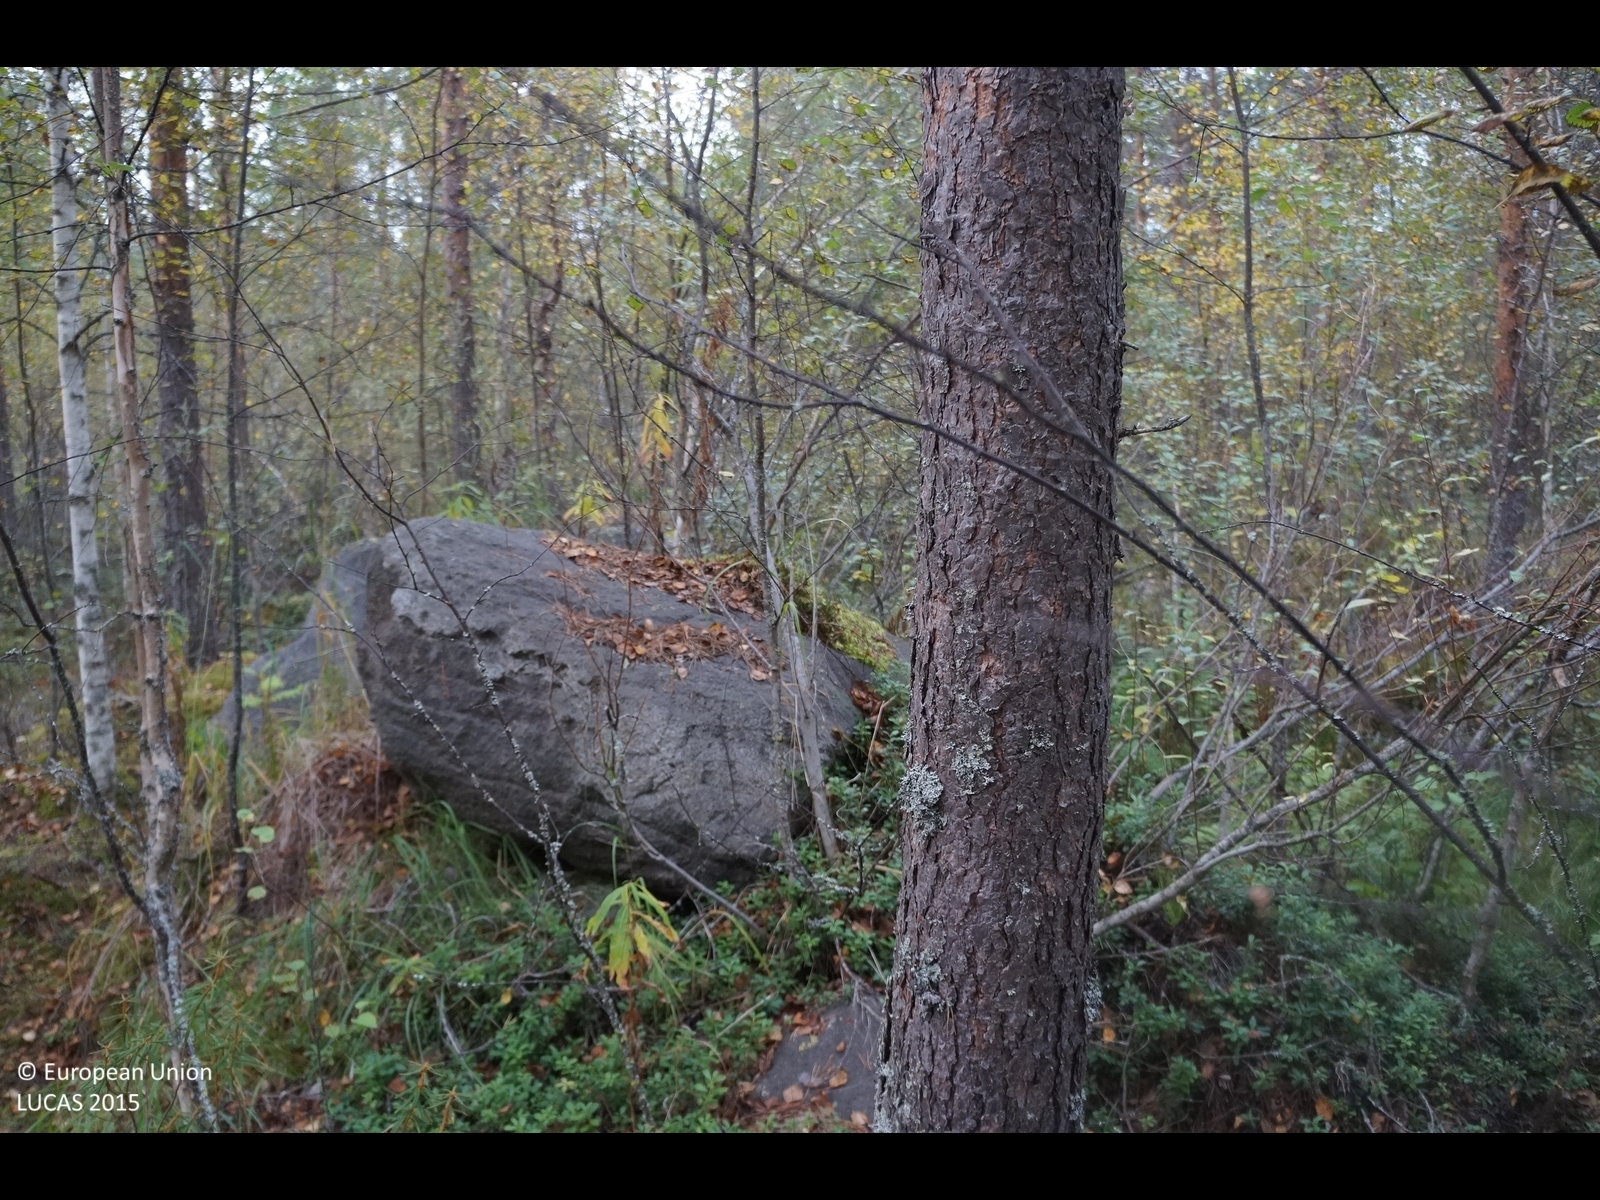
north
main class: Woodland
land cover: Pine dominated mixed woodland
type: boreal forest
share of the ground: 50 - 75 %
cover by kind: coniferous forest trees 40 %, broadleaved forest trees 20 %, shrubs 20 %, herbaceous plants 15 %, lichens and mosses 5 %
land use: Forestry
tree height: > 5 m
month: September
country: FI
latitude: 64.0758
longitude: 24.3189
